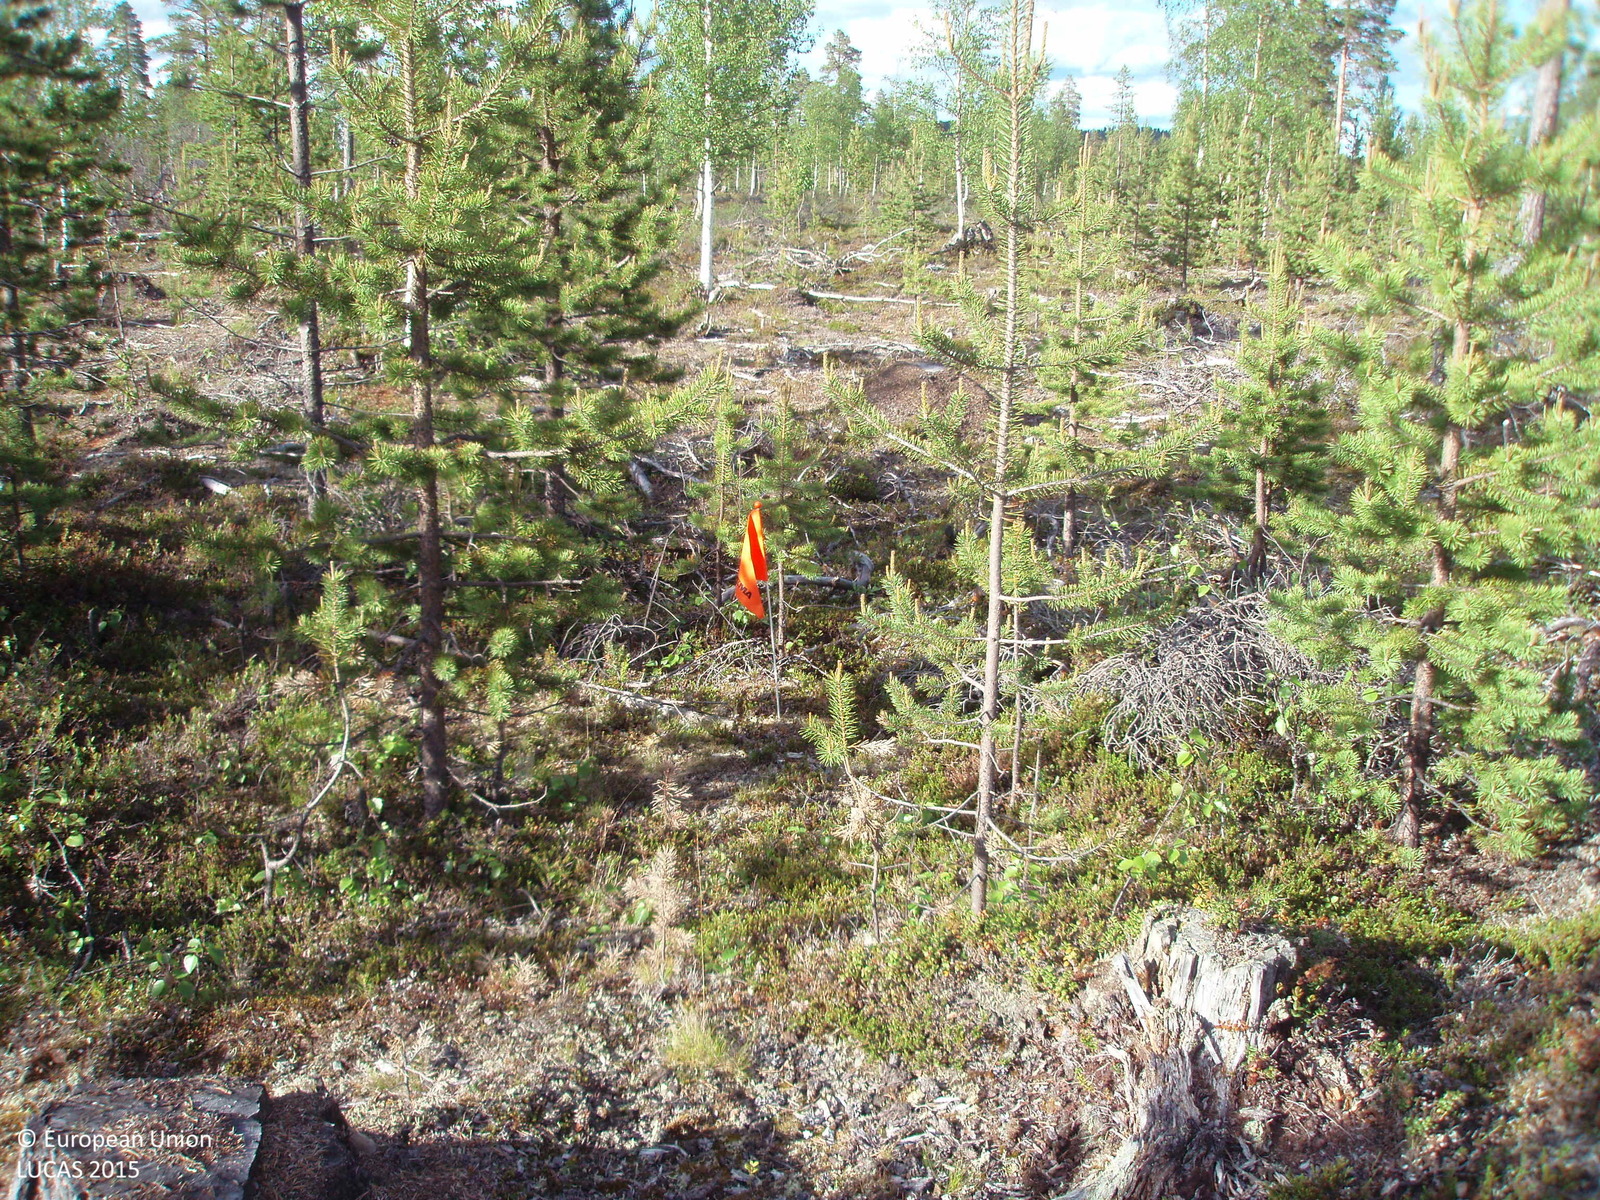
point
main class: Woodland
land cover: Pine dominated mixed woodland
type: boreal forest
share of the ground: 25 - 50 %
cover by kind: shrubs 45 %, coniferous forest trees 30 %, broadleaved forest trees 15 %, lichens and mosses 10 %
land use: Forestry
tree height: > 5 m
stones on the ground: < 10 %
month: June
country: FI
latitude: 68.6918
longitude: 26.3471
